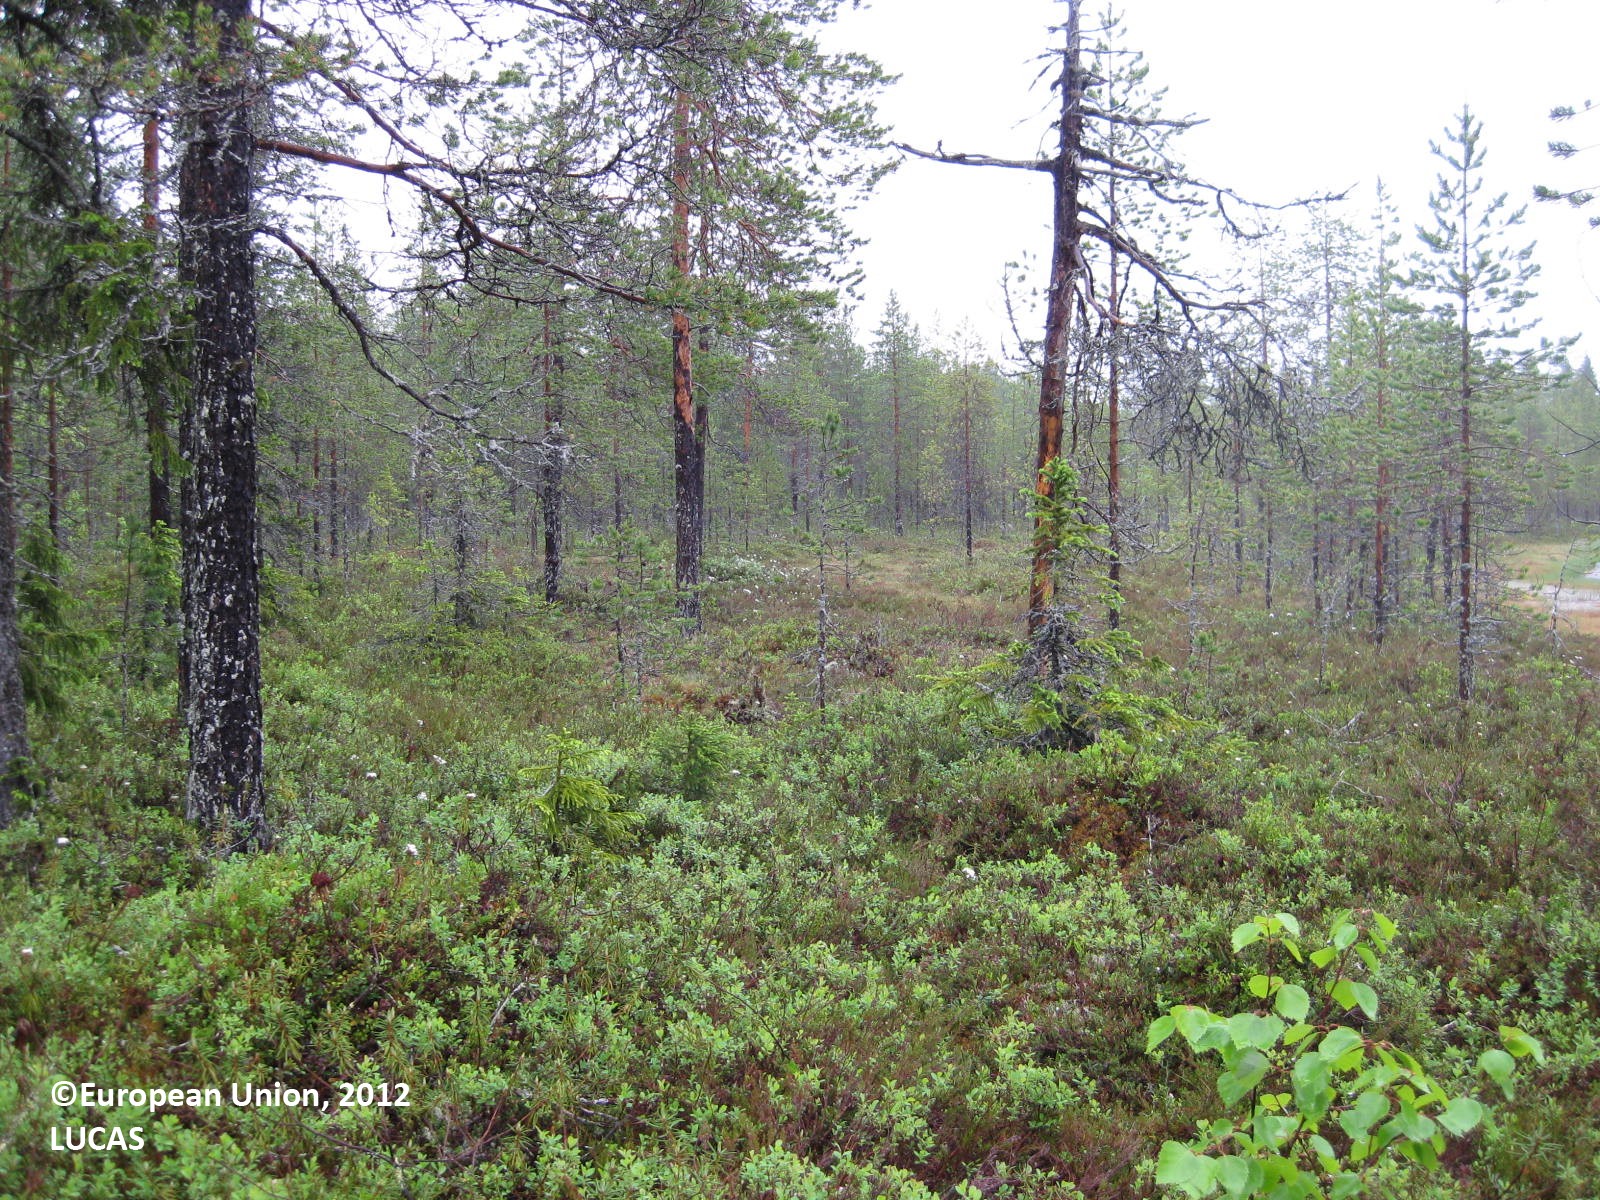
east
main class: Woodland
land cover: Pine dominated mixed woodland
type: boreal forest
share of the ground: 50 - 75 %
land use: Forestry
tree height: > 5 m
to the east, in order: Pine dominated mixed woodland; Pine dominated coniferous woodland; Pine dominated mixed woodland; Pine dominated coniferous woodland; Pine dominated mixed woodland; Tracks; Pine dominated coniferous woodland; Pine dominated mixed woodland
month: June
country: FI
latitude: 65.2758
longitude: 28.9740
